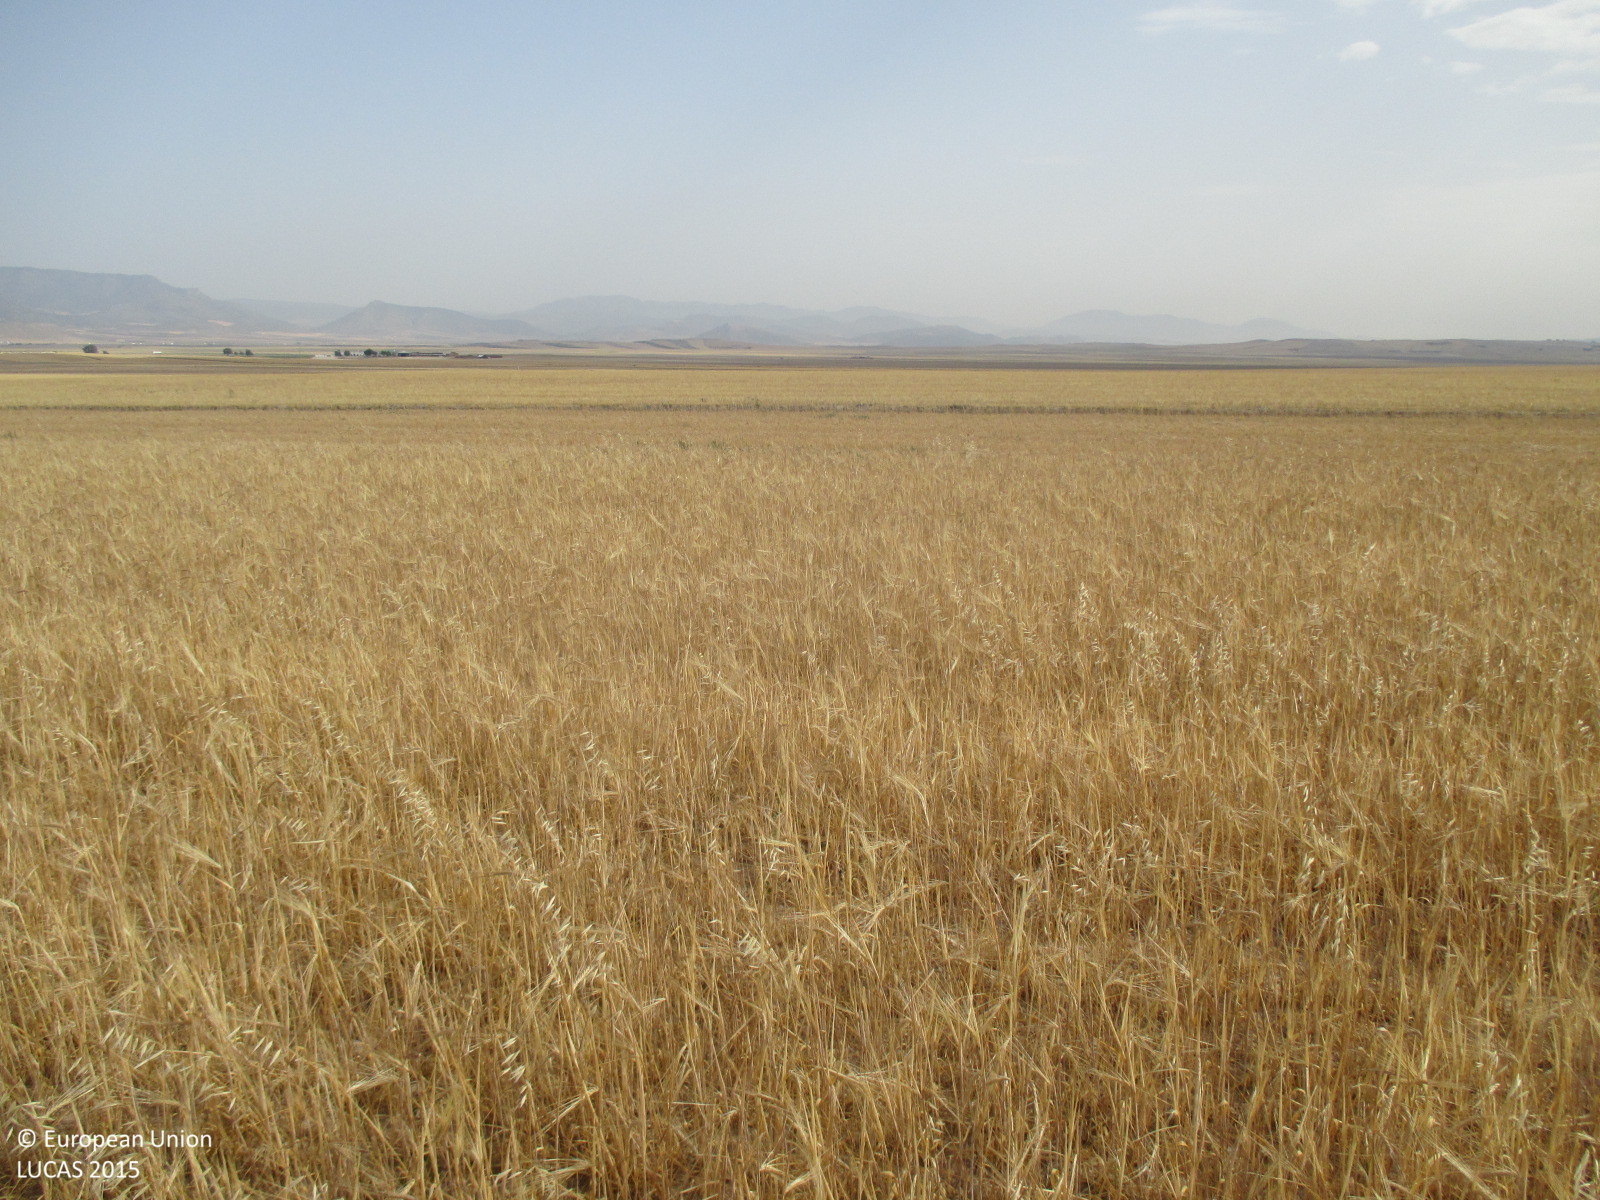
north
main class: Cropland
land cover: Barley
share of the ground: 50 - 75 %
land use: Agriculture (excluding fallow land and kitchen gardens)
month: July
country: ES
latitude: 37.7936
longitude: -2.4010
